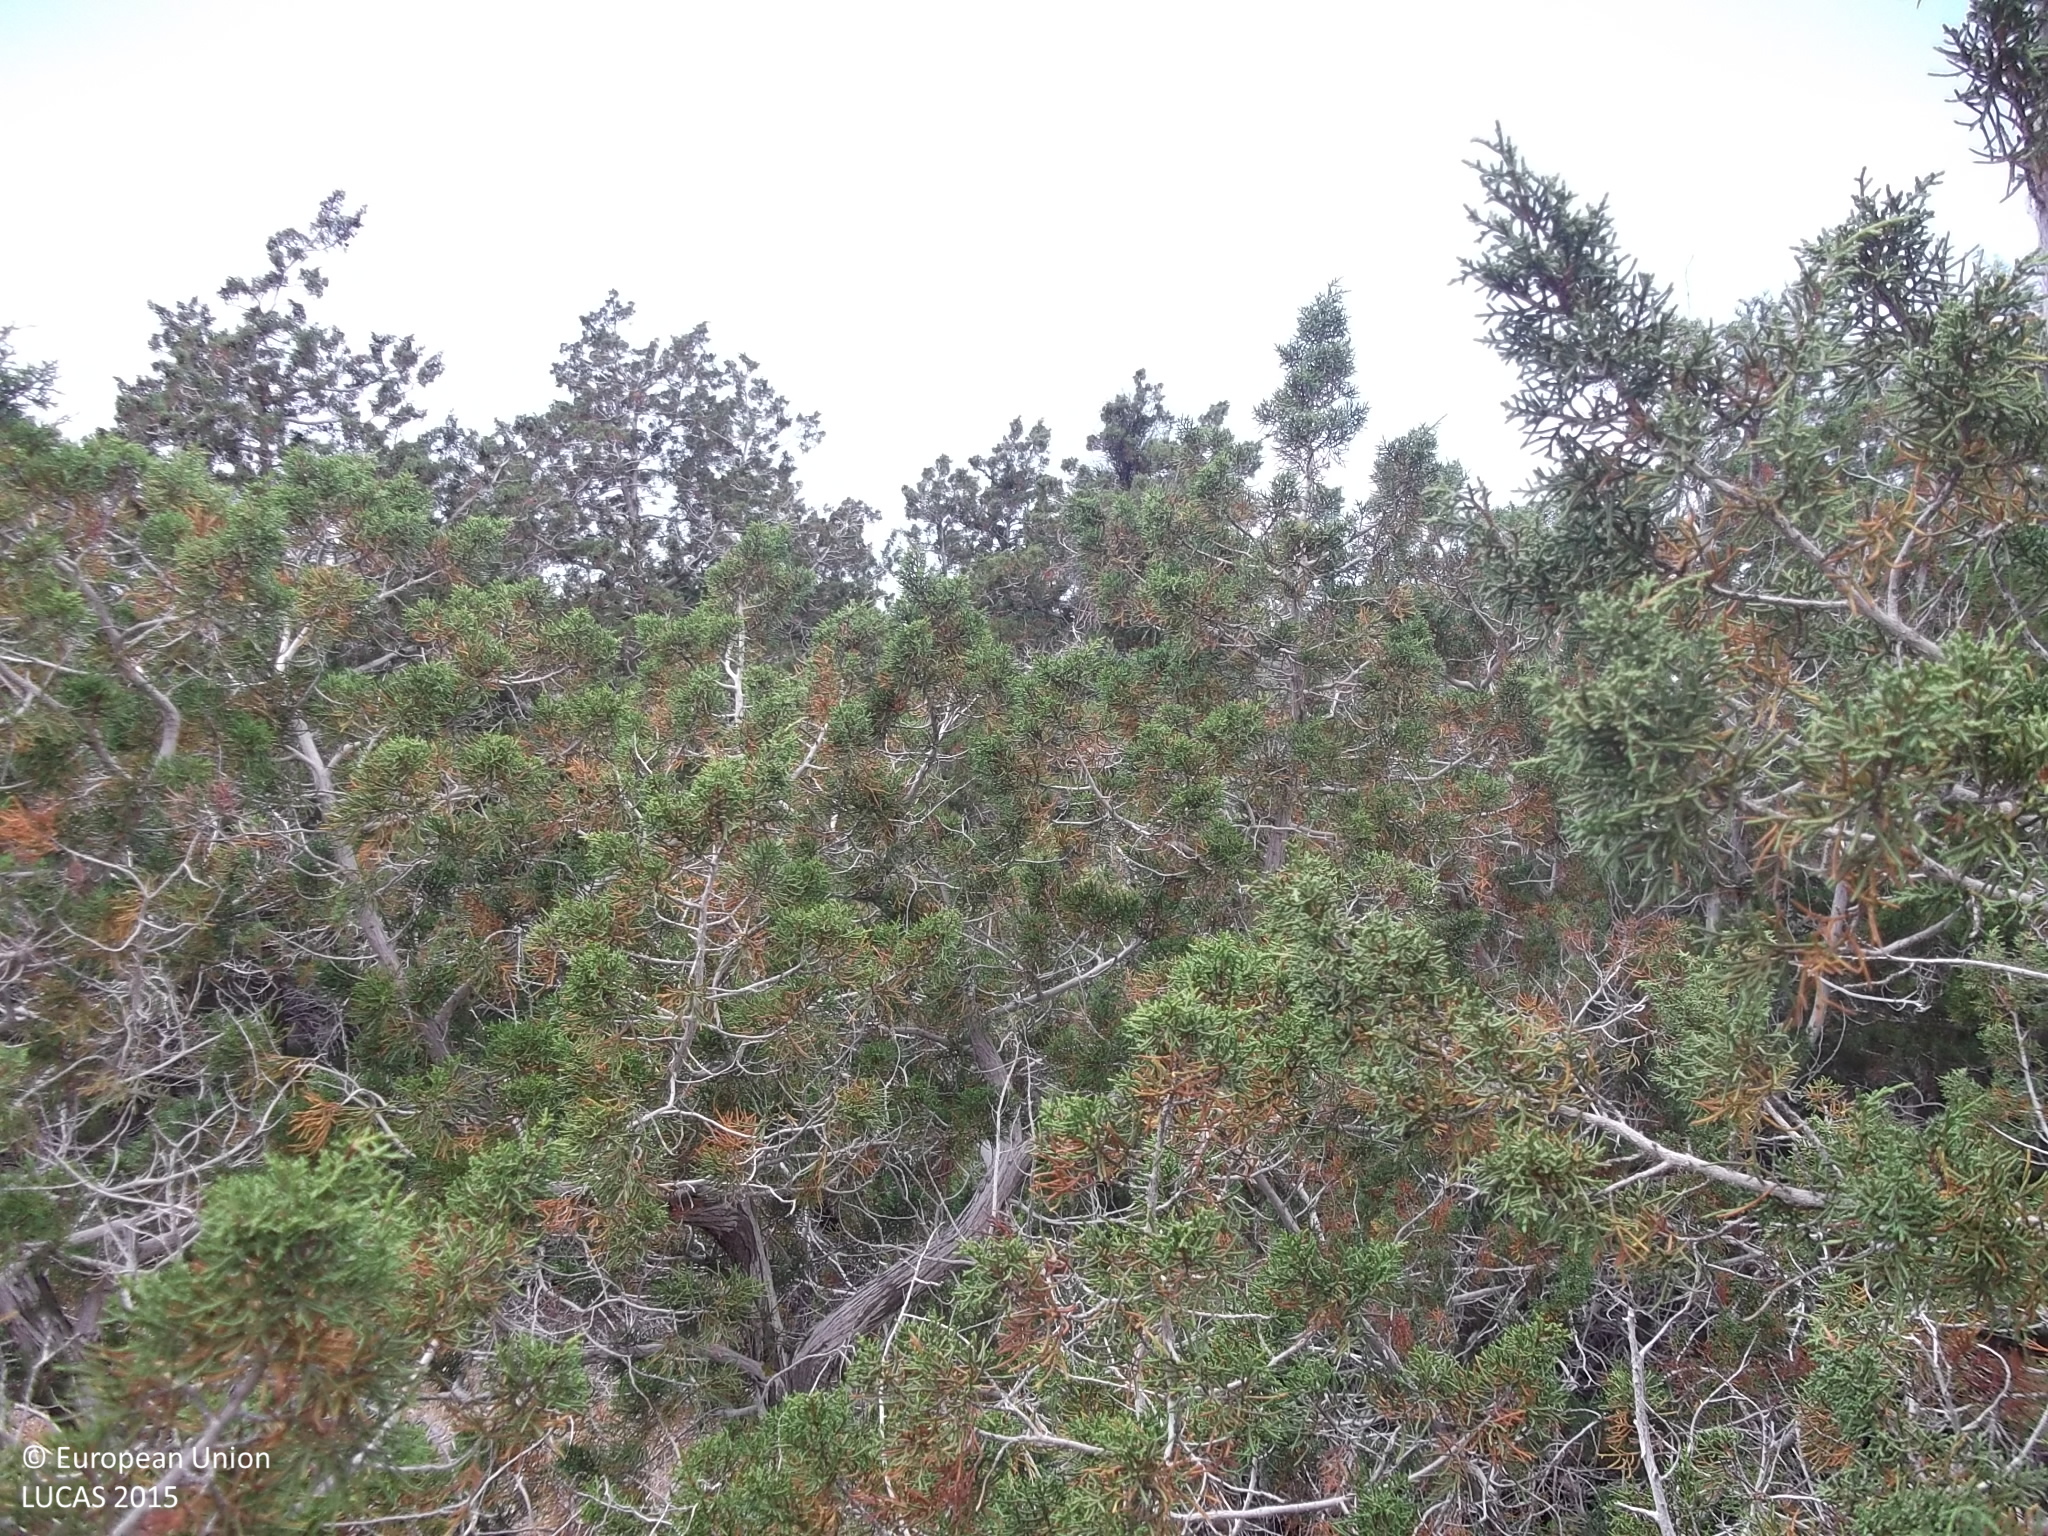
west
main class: Woodland
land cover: Other coniferous woodland
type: coniferous forest of the mediterranean region
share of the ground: > 75 %
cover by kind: coniferous forest trees 75 %, herbaceous plants 20 %, unconsolidated bare surface 5 %
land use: Agriculture (excluding fallow land and kitchen gardens)
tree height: < 5 m
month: May
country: CY
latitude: 35.0264
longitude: 32.2991
